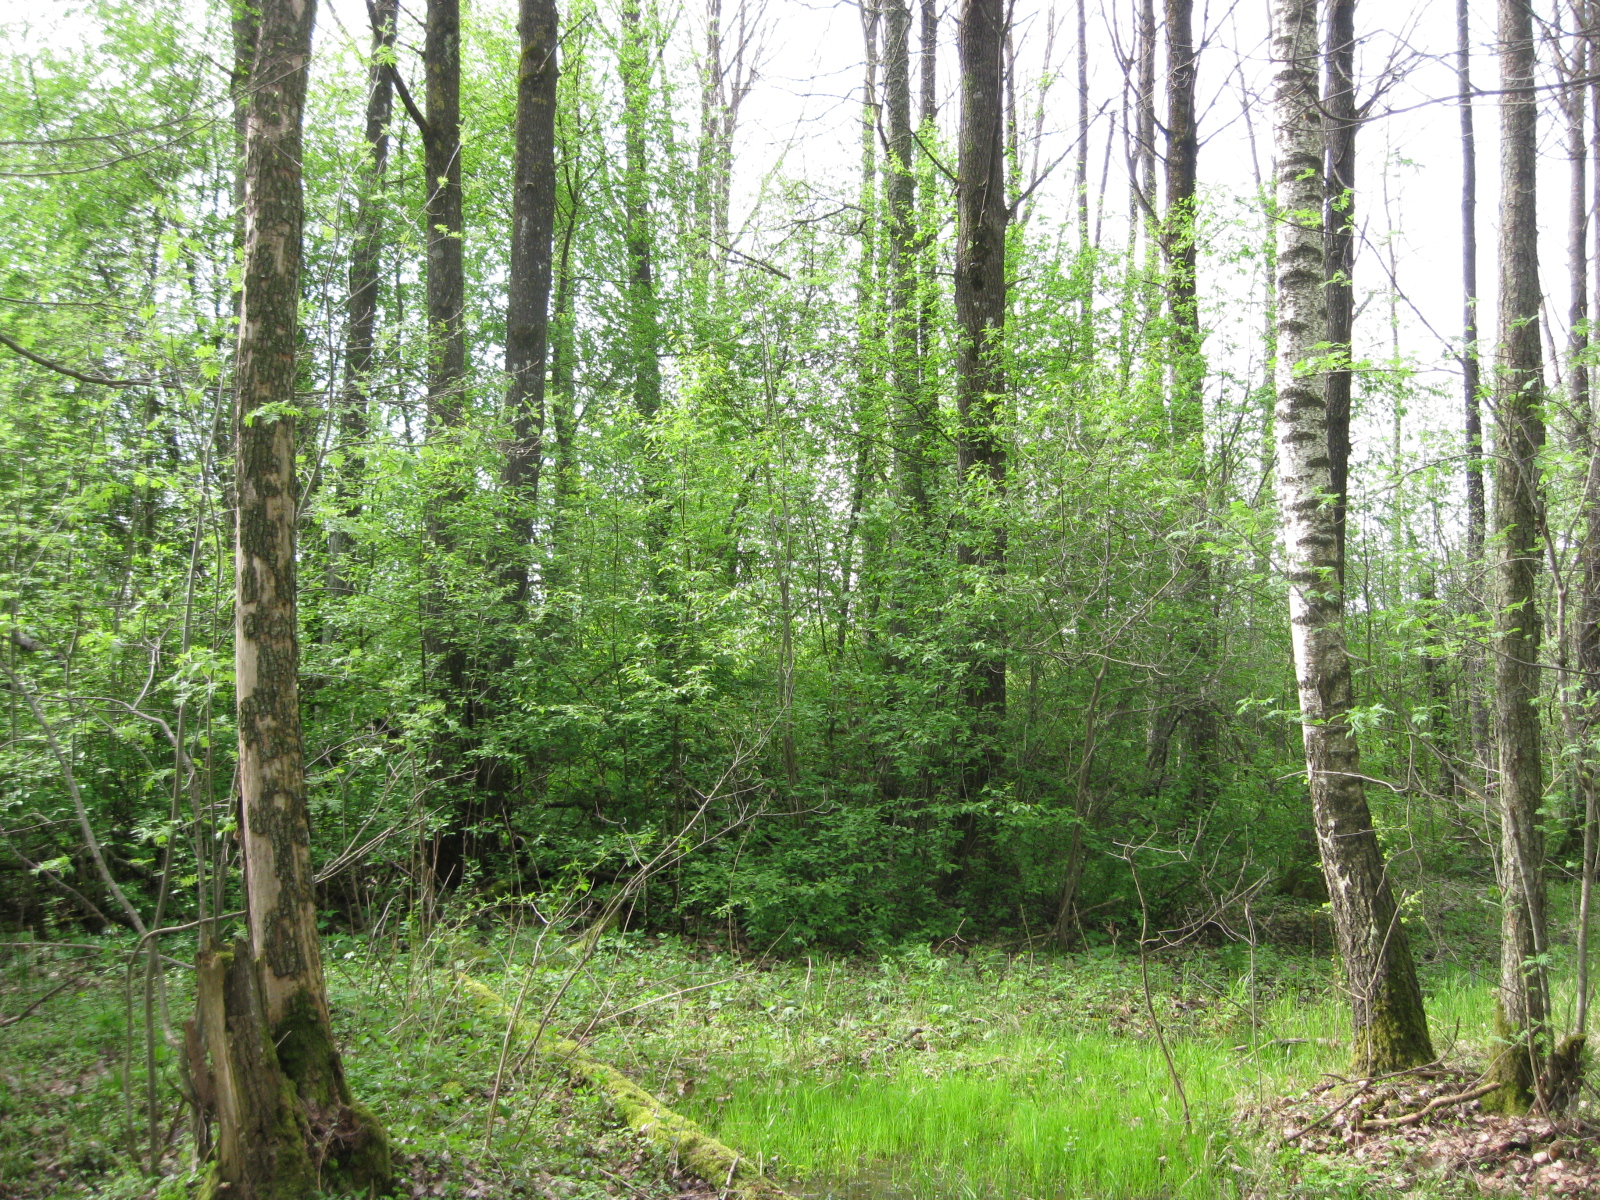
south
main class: Woodland
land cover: Broadleaved woodland
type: non-riverine alder, birch or aspen forest
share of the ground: > 75 %
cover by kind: broadleaved forest trees 85 %, herbaceous plants 10 %, shrubs 5 %
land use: Forestry
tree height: > 5 m
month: May
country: LT
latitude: 56.2536
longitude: 24.5110
